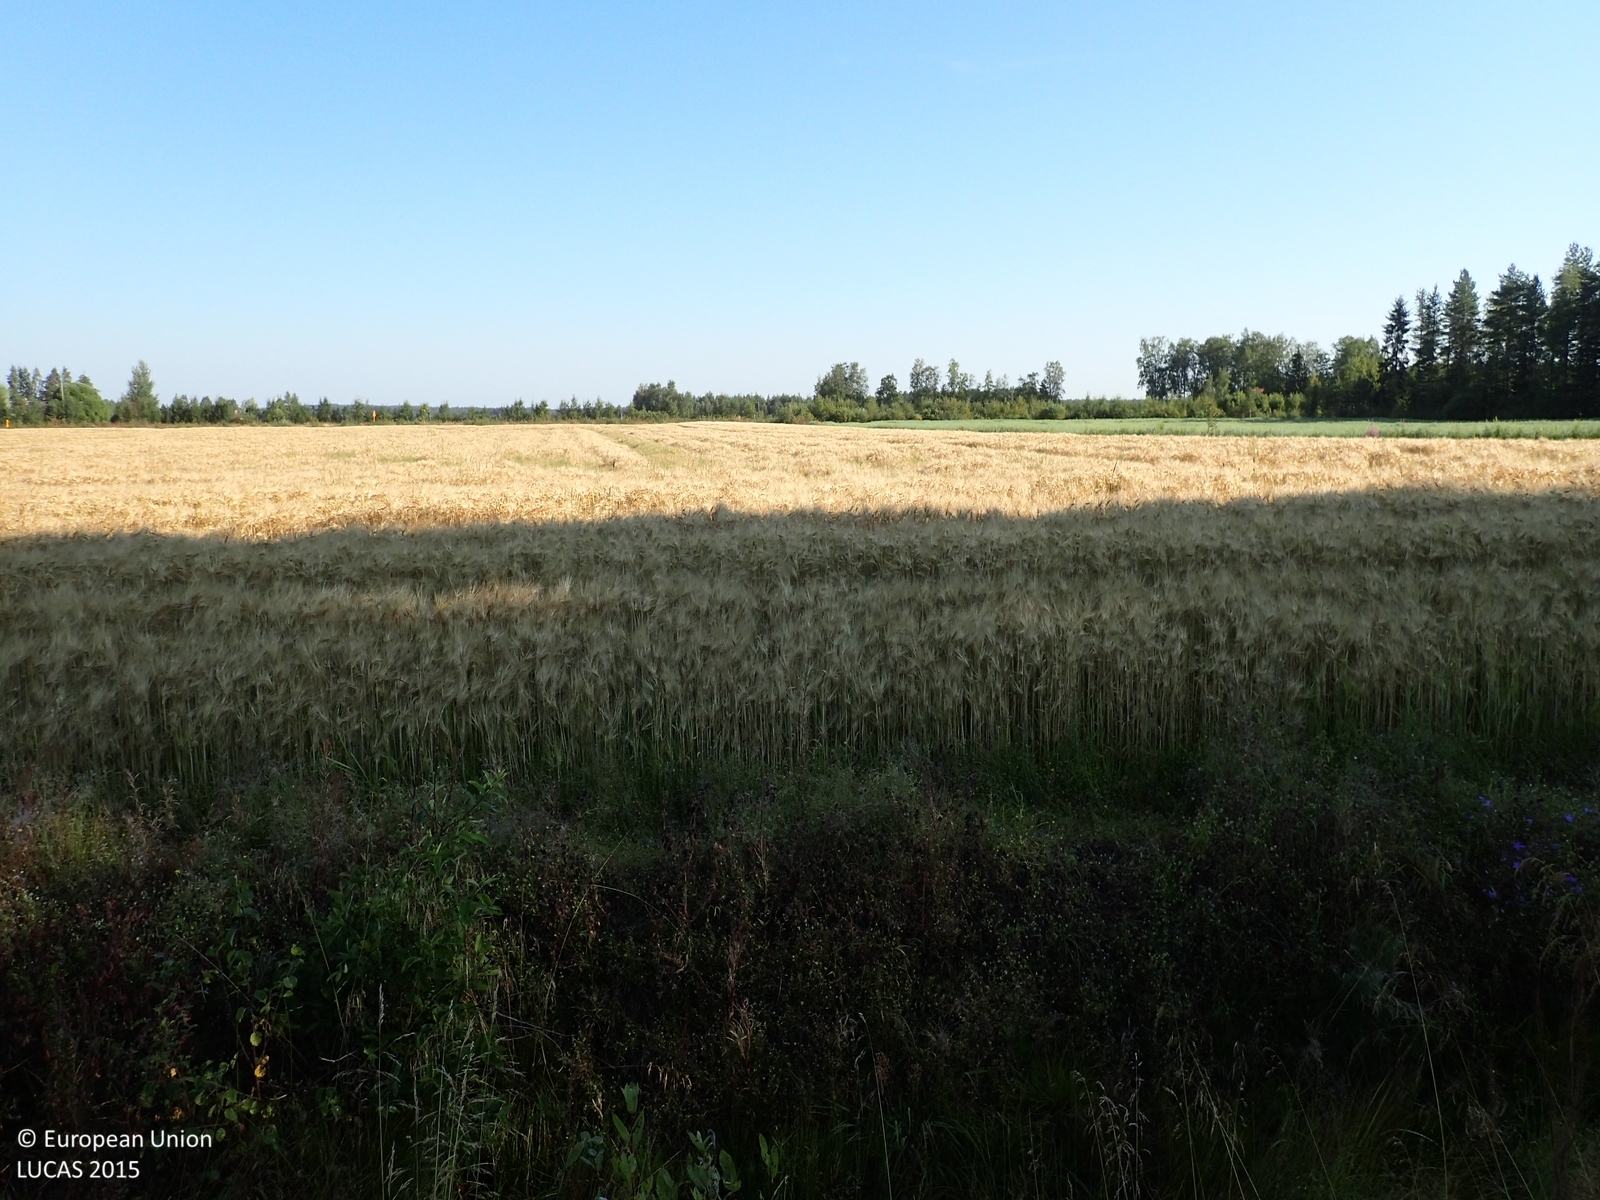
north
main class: Cropland
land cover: Temporary grasslands
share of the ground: > 75 %
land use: Agriculture (excluding fallow land and kitchen gardens)
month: August
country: FI
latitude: 62.4617
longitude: 21.9726
